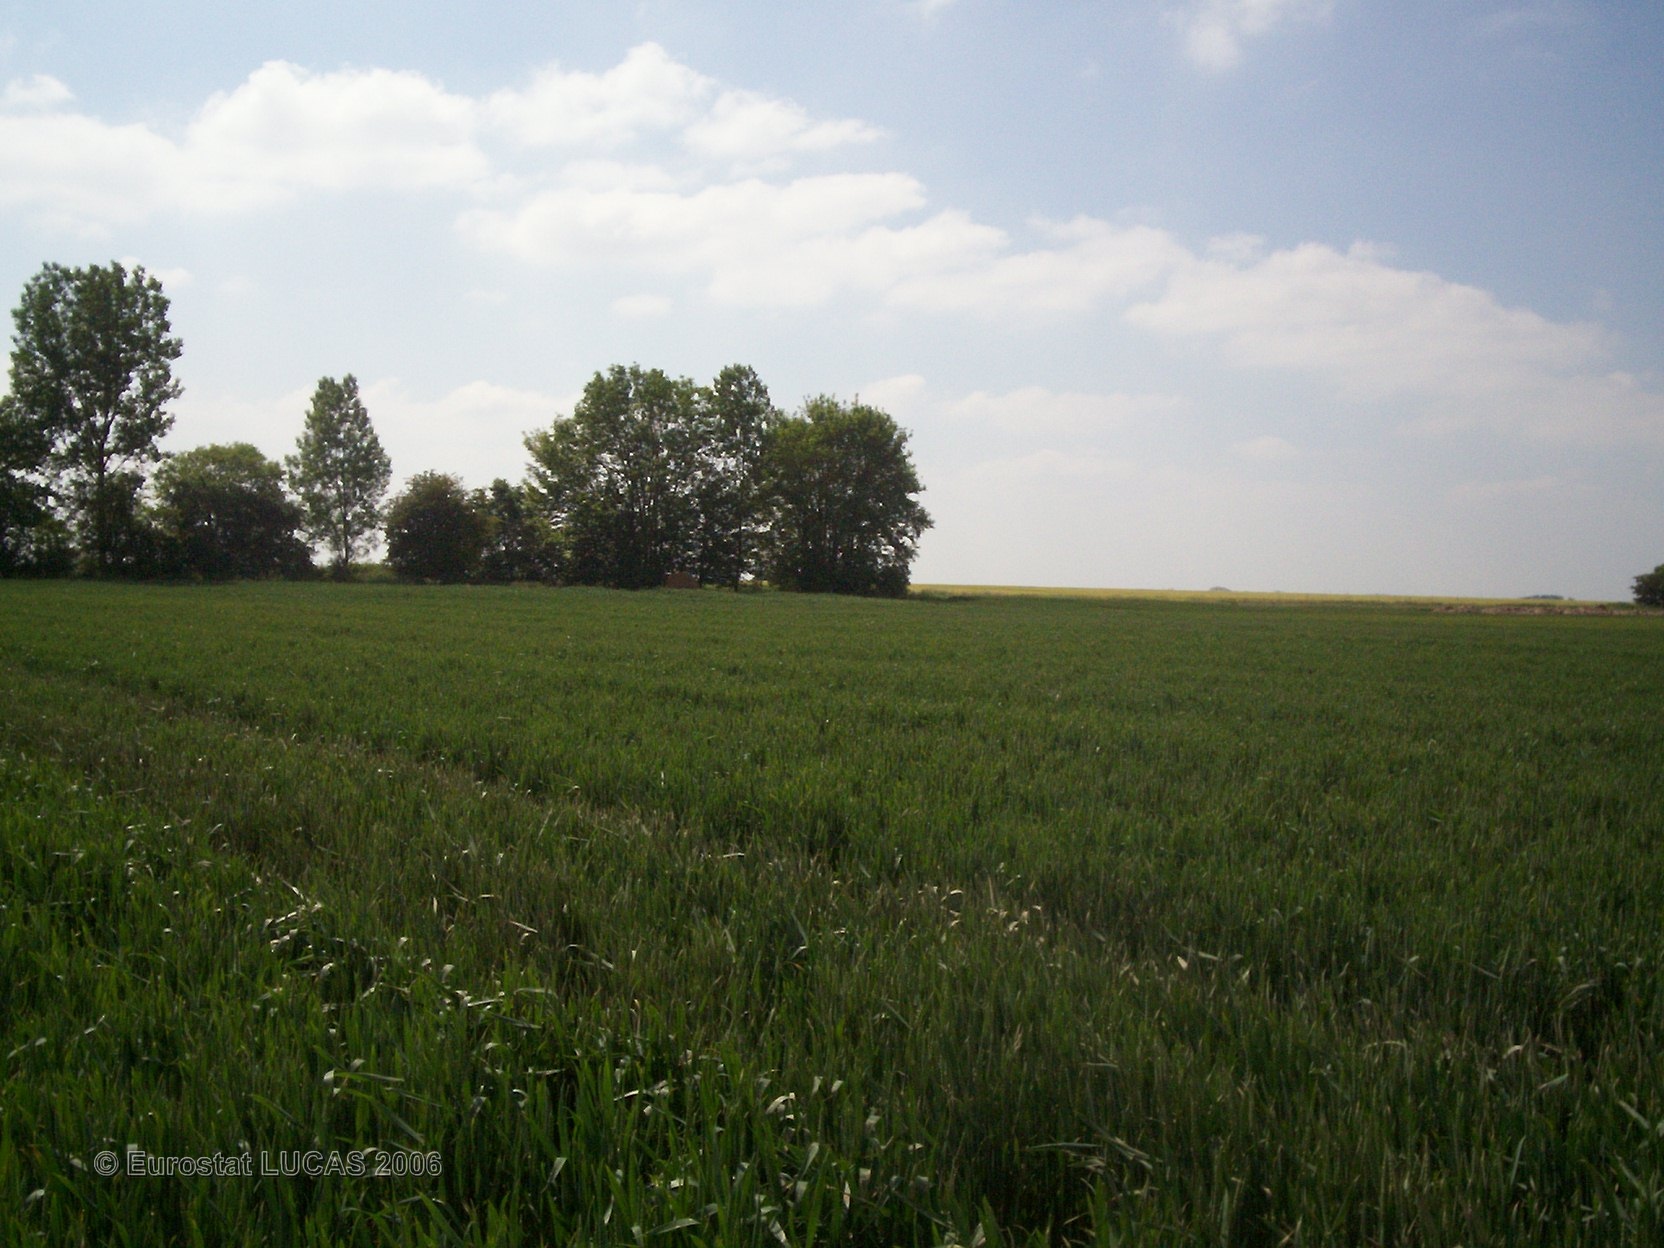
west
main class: Cropland
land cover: Common wheat
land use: Agriculture (excluding fallow land and kitchen gardens)
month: June
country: FR
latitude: 49.7856
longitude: 2.6690
